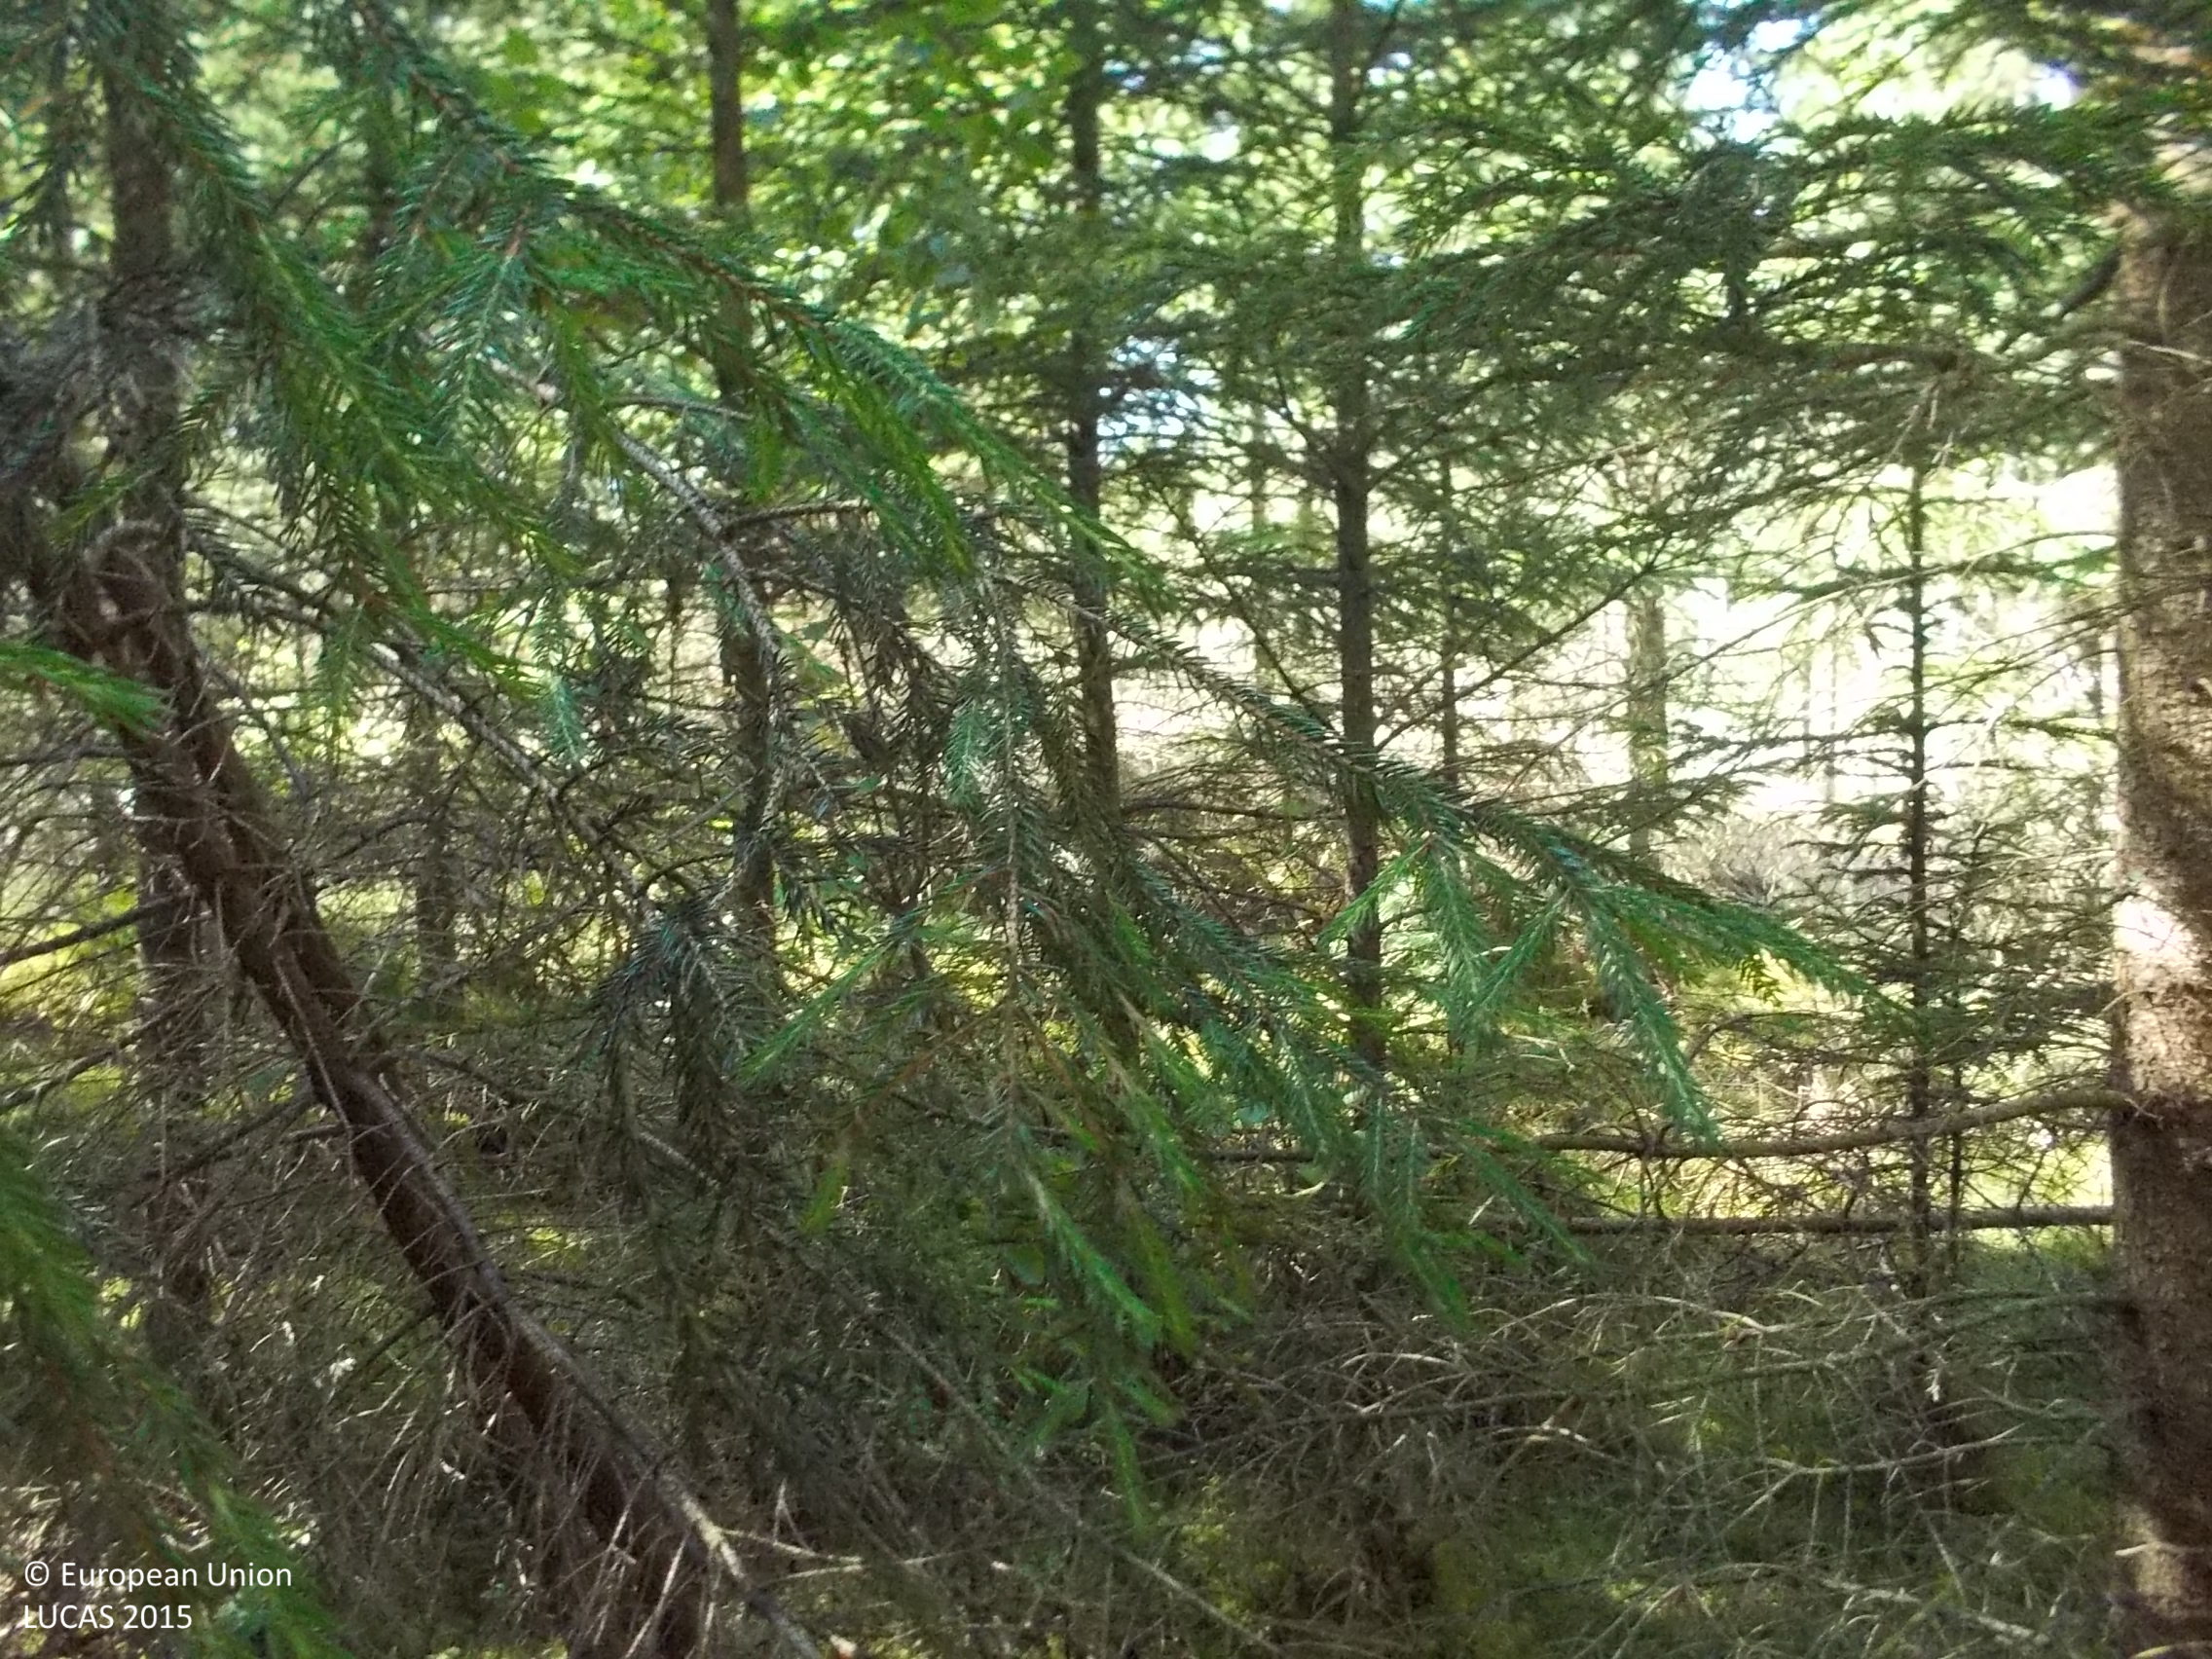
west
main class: Woodland
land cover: Spruce dominated coniferous woodland
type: boreal forest
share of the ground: > 75 %
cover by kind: coniferous forest trees 90 %, shrubs 5 %, lichens and mosses 5 %
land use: Forestry
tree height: > 5 m
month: August
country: SE
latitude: 57.5142
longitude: 13.2509
